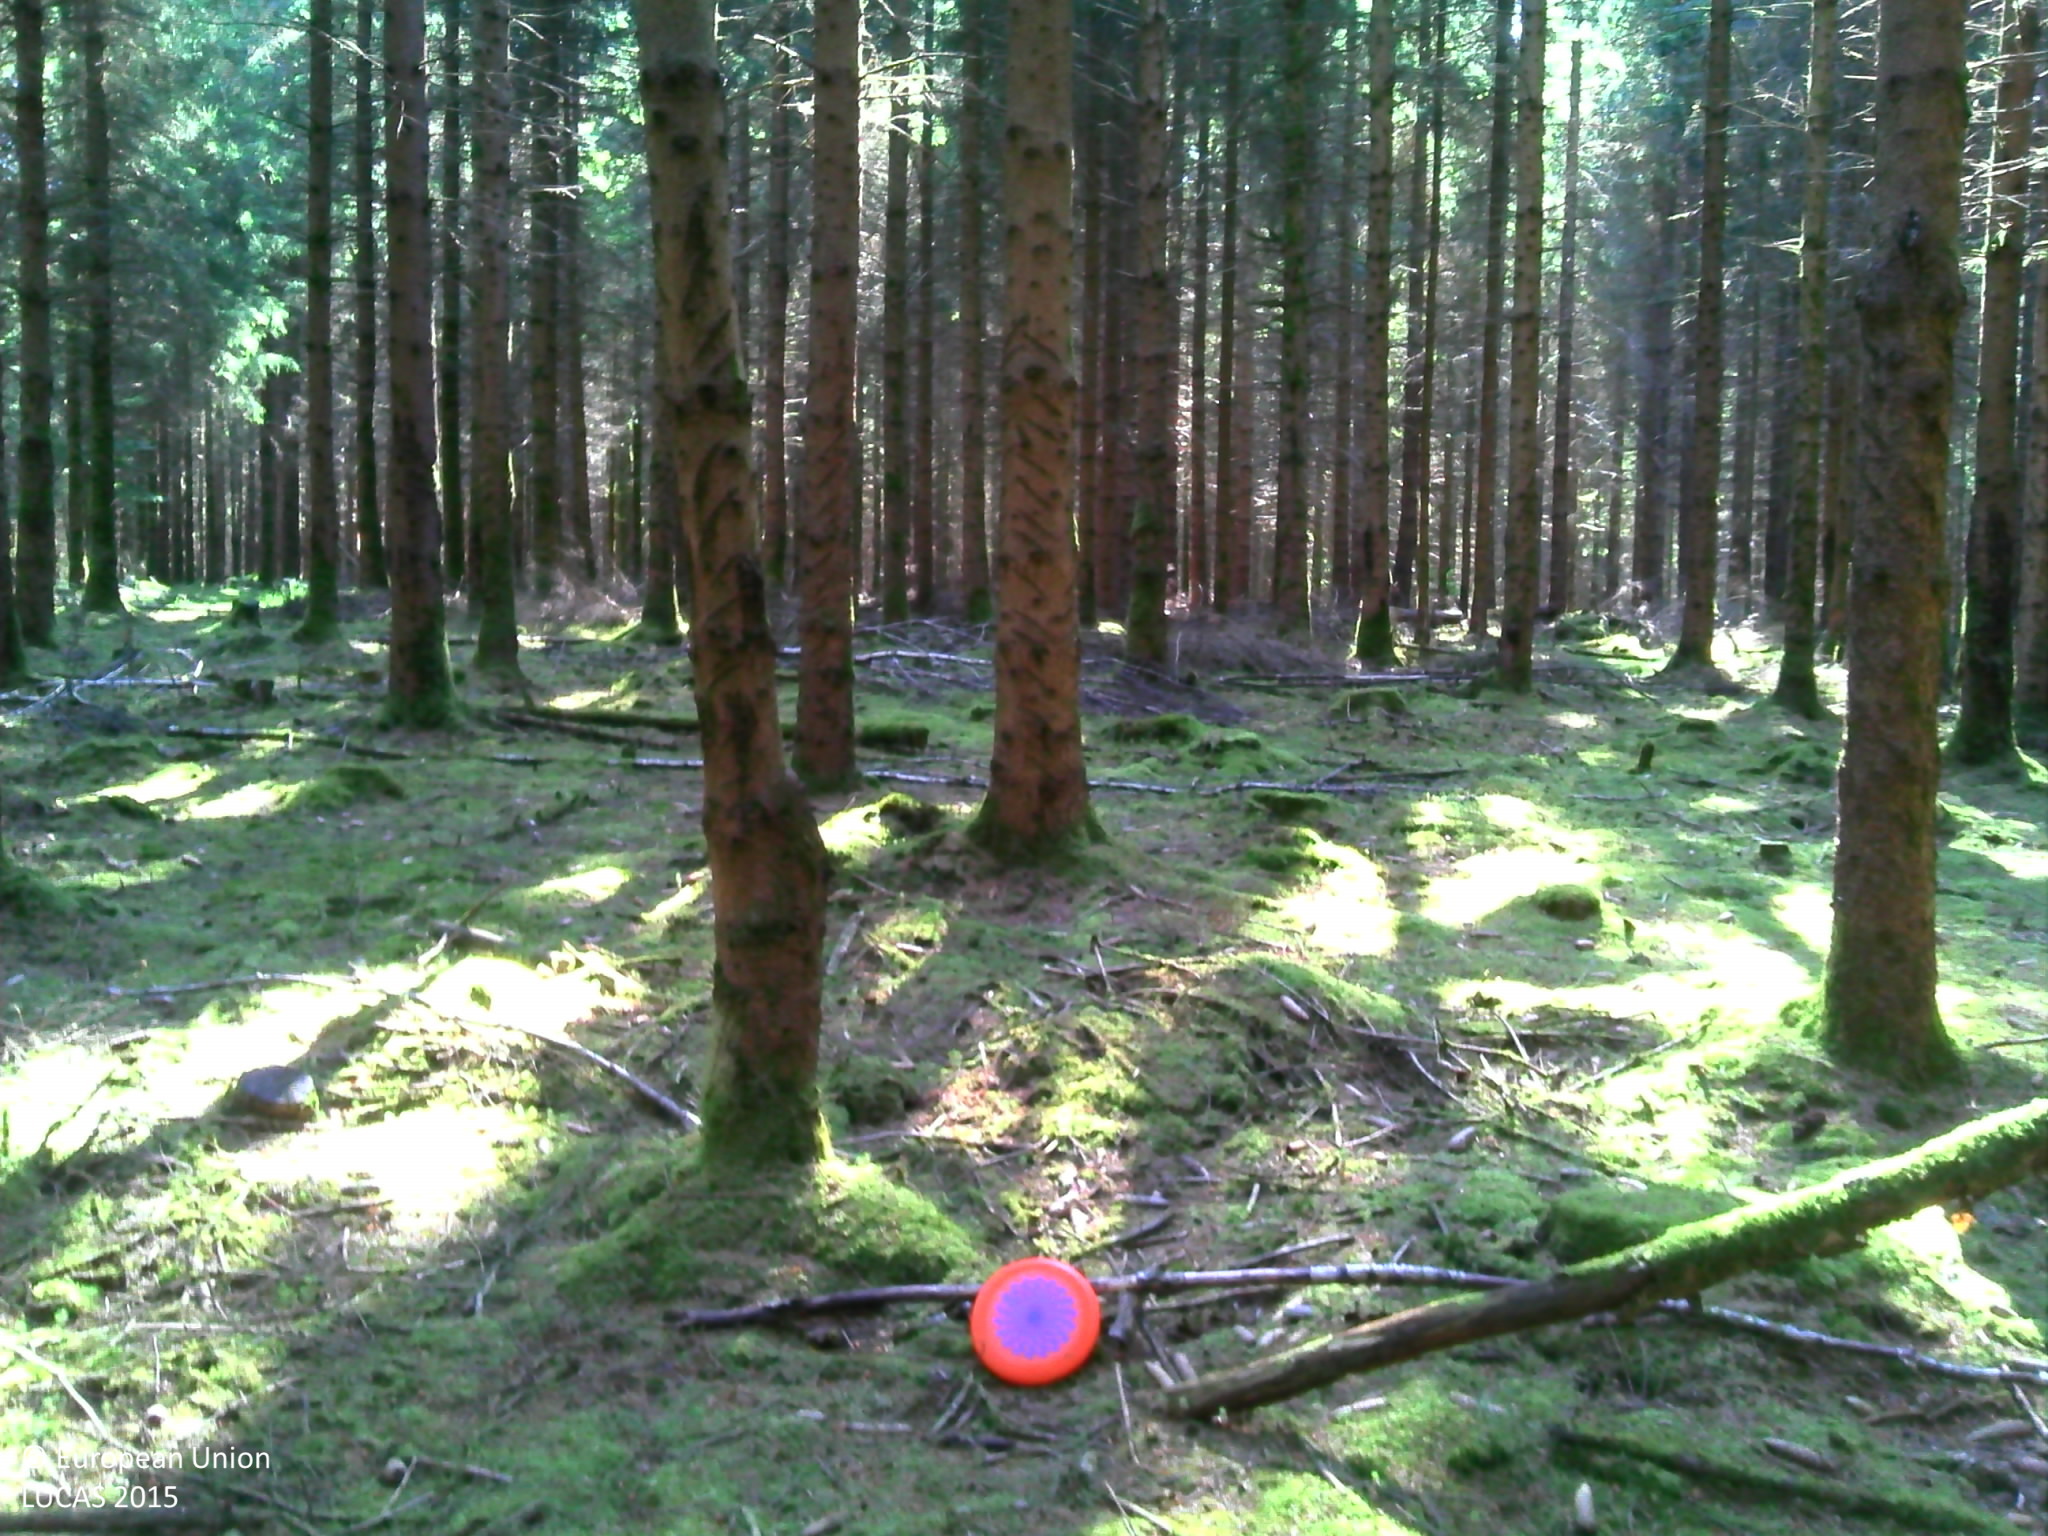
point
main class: Woodland
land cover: Spruce dominated coniferous woodland
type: alpine coniferous forest
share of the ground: > 75 %
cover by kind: coniferous forest trees 95 %, lichens and mosses 5 %
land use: Forestry
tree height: > 5 m
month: July
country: BE
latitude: 50.1773
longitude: 5.7558
